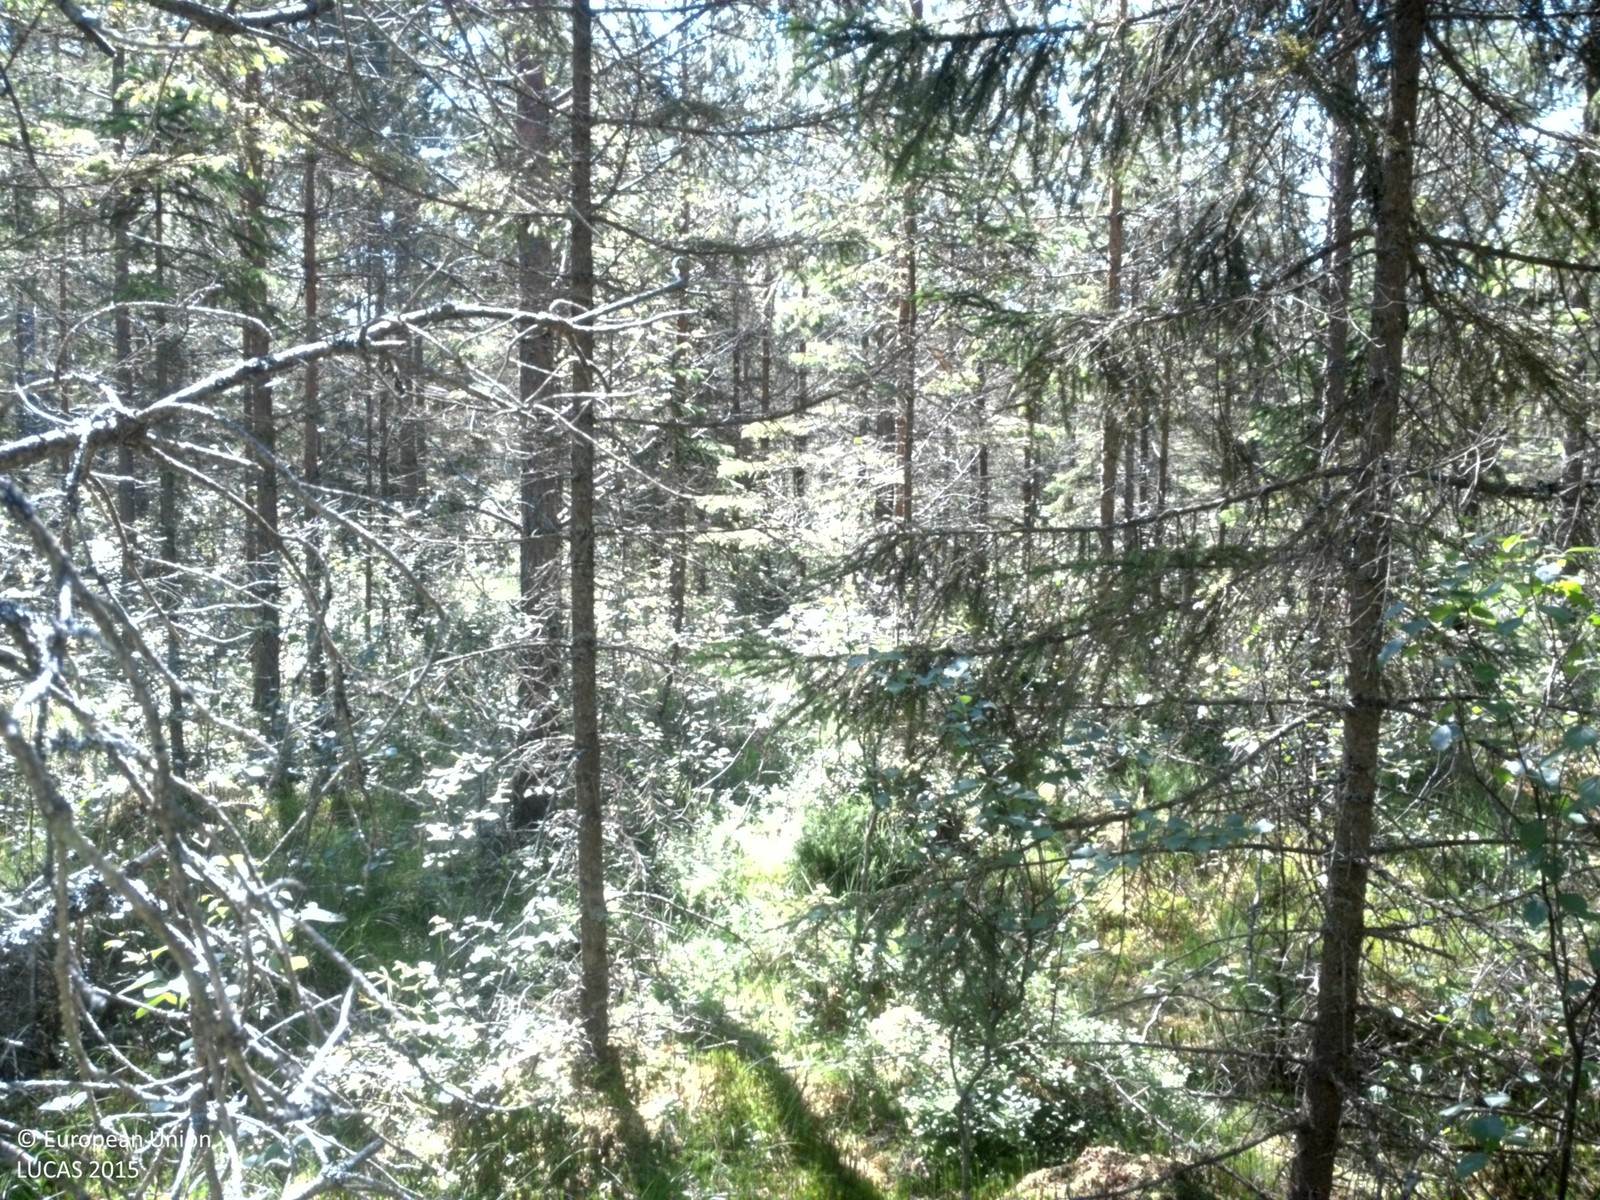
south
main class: Woodland
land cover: Other coniferous woodland
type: boreal forest
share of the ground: 50 - 75 %
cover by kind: coniferous forest trees 60 %, broadleaved forest trees 10 %, shrubs 10 %, herbaceous plants 10 %, lichens and mosses 10 %
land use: Forestry
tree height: > 5 m
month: July
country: SE
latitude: 59.6327
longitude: 14.7255
